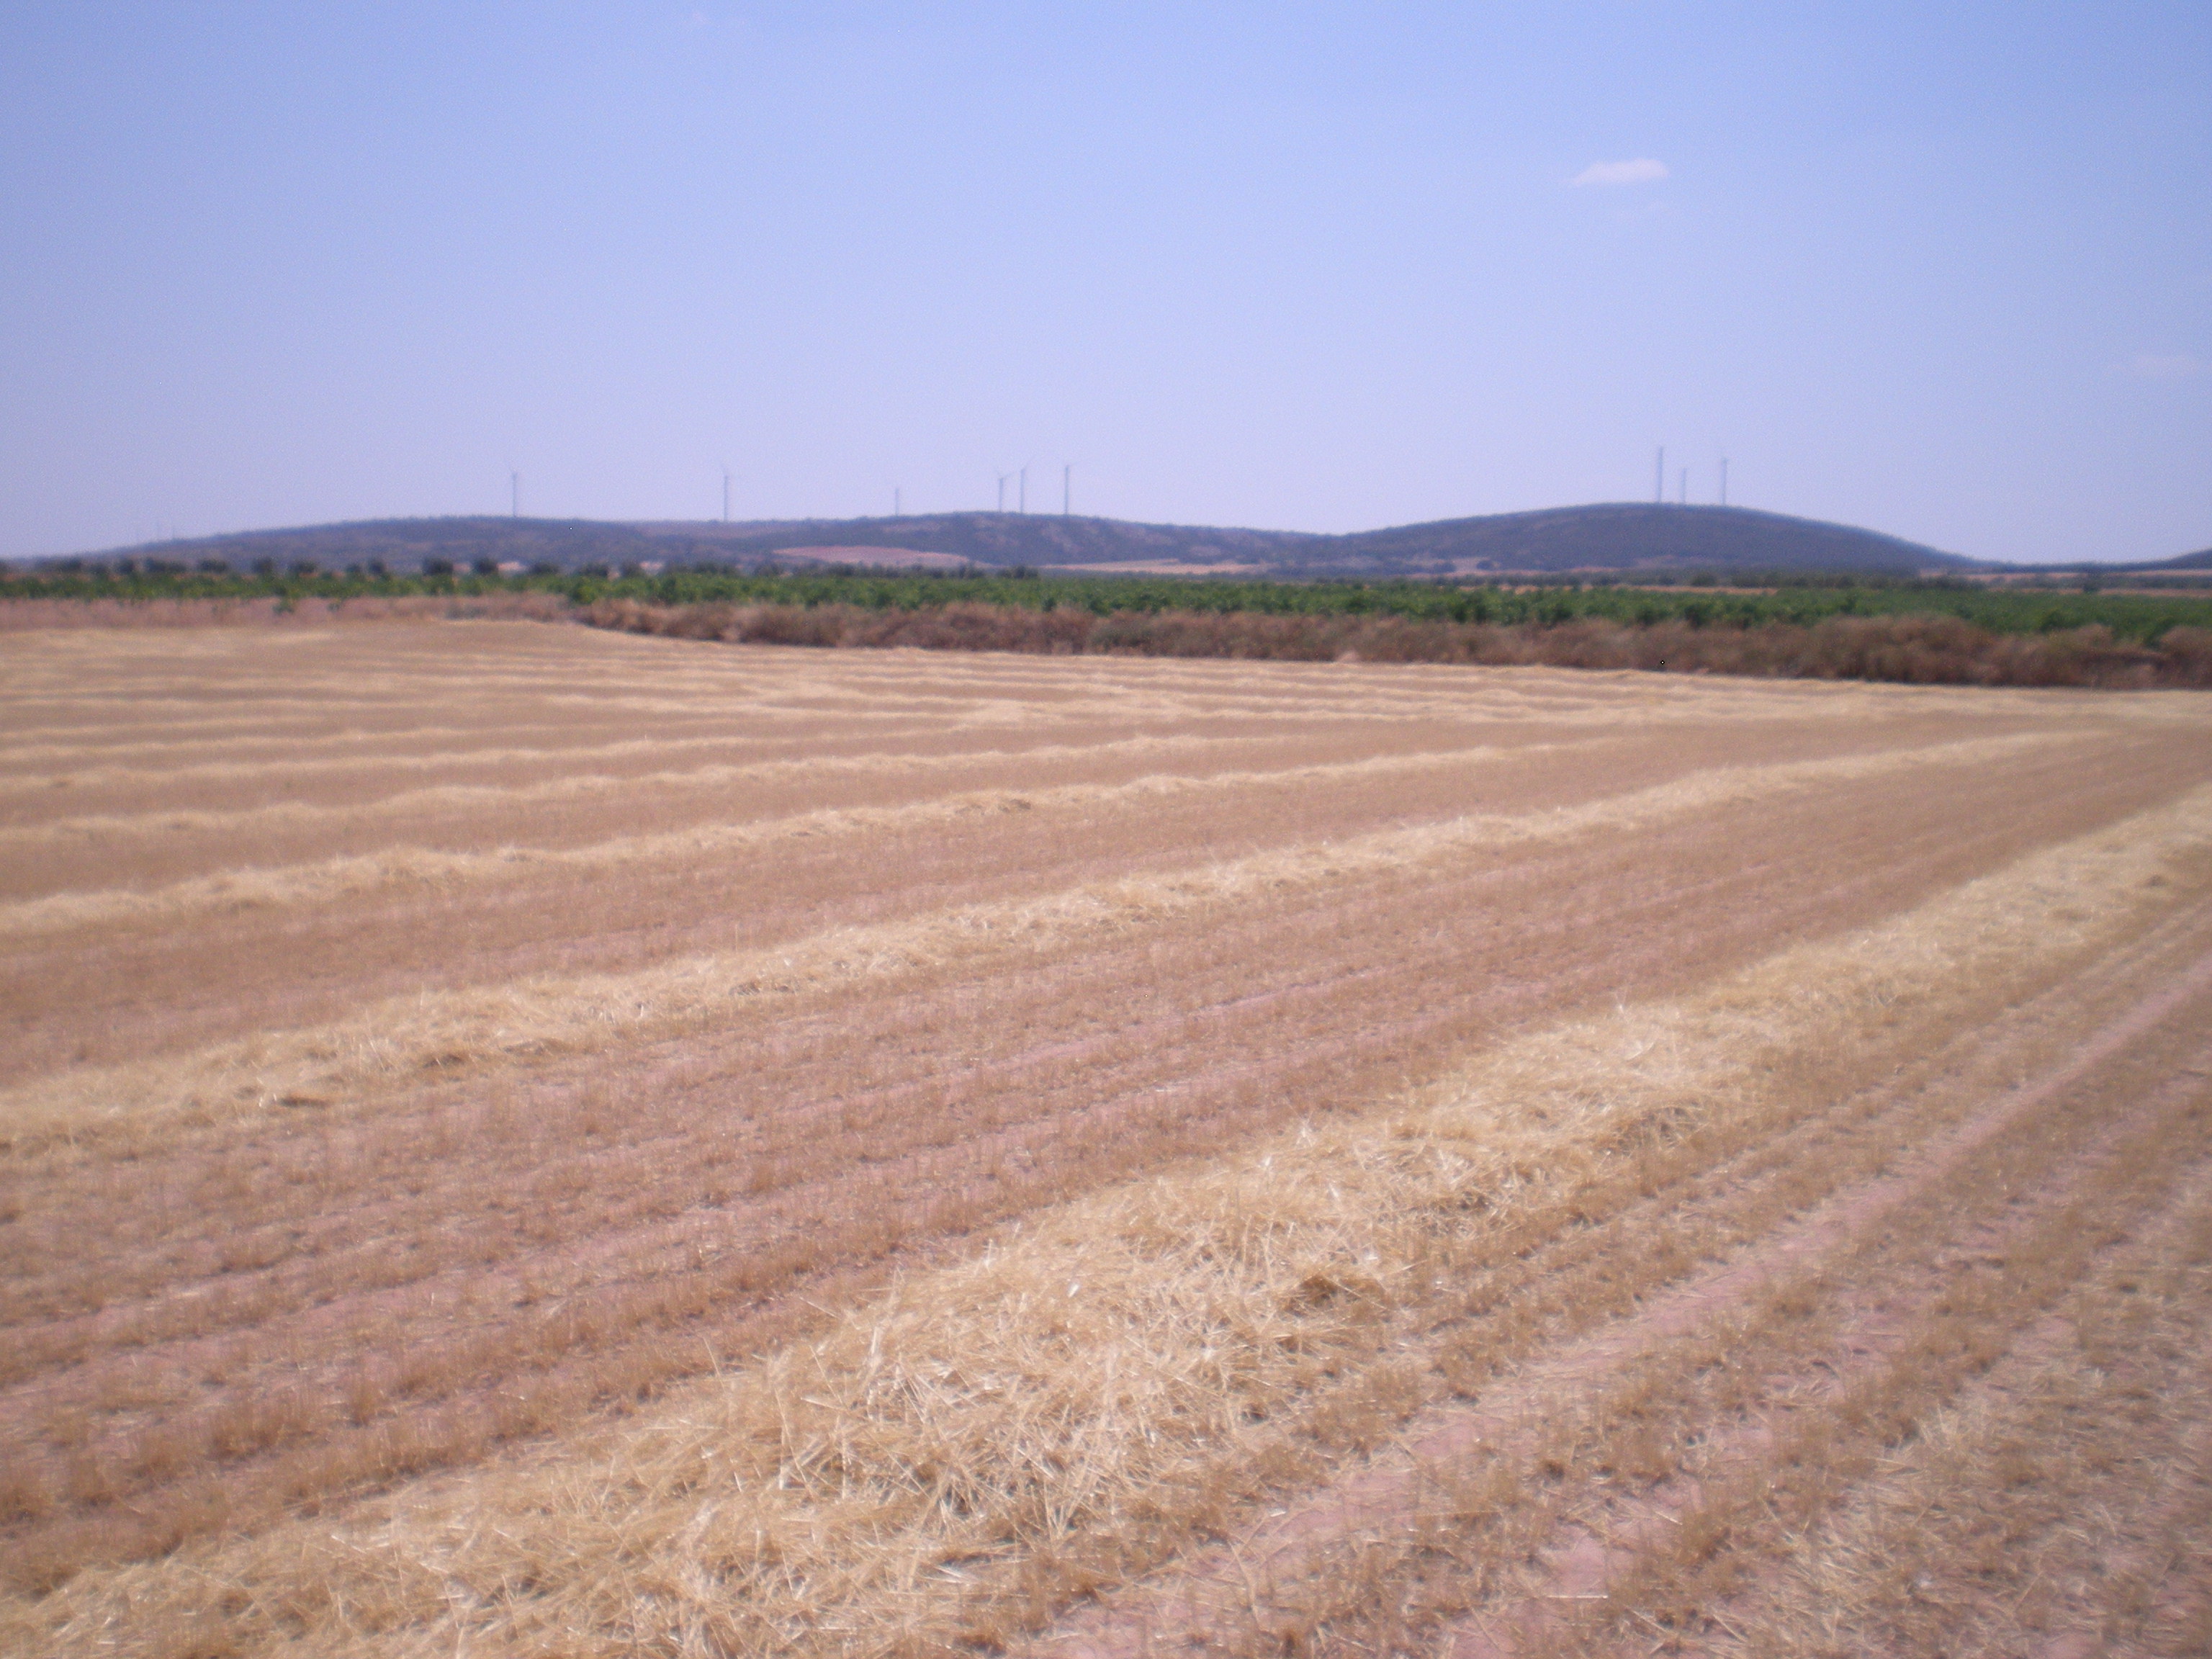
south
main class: Cropland
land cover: Barley
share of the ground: < 10 %
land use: Agriculture (excluding fallow land and kitchen gardens)
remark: Harvested field
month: June
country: ES
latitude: 39.6592
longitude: -3.3689
